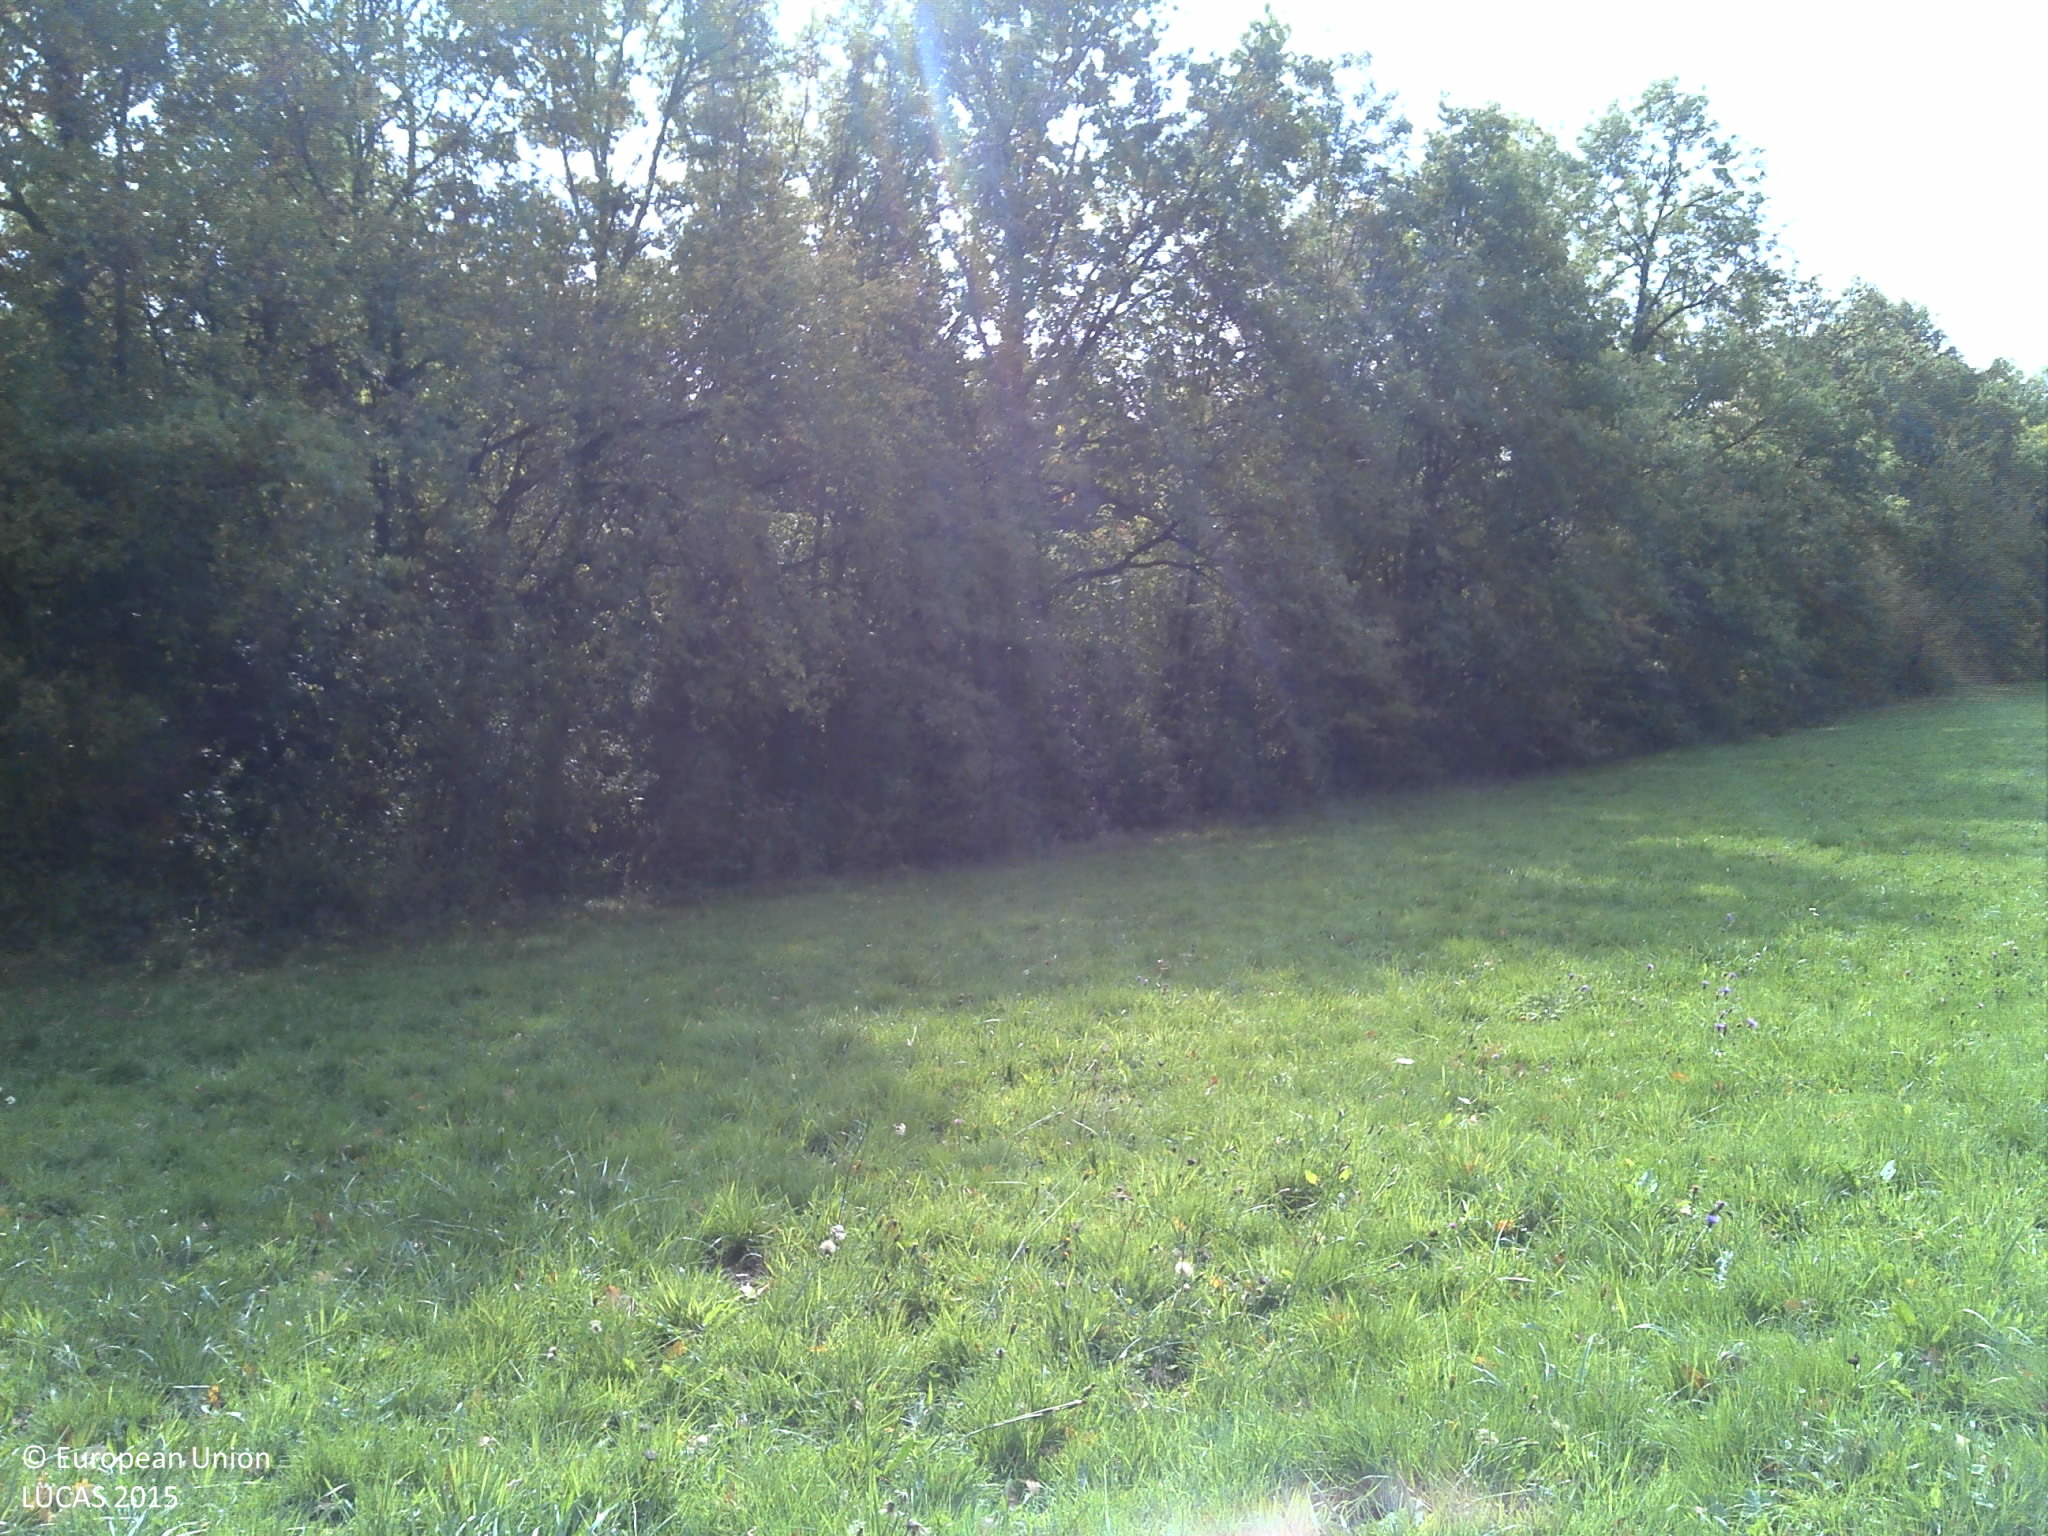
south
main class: Grassland
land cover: Grassland without tree/shrub cover
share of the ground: > 75 %
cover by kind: herbaceous plants 100 %
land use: Agriculture (excluding fallow land and kitchen gardens)
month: October
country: FR
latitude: 46.3160
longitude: 6.0943
